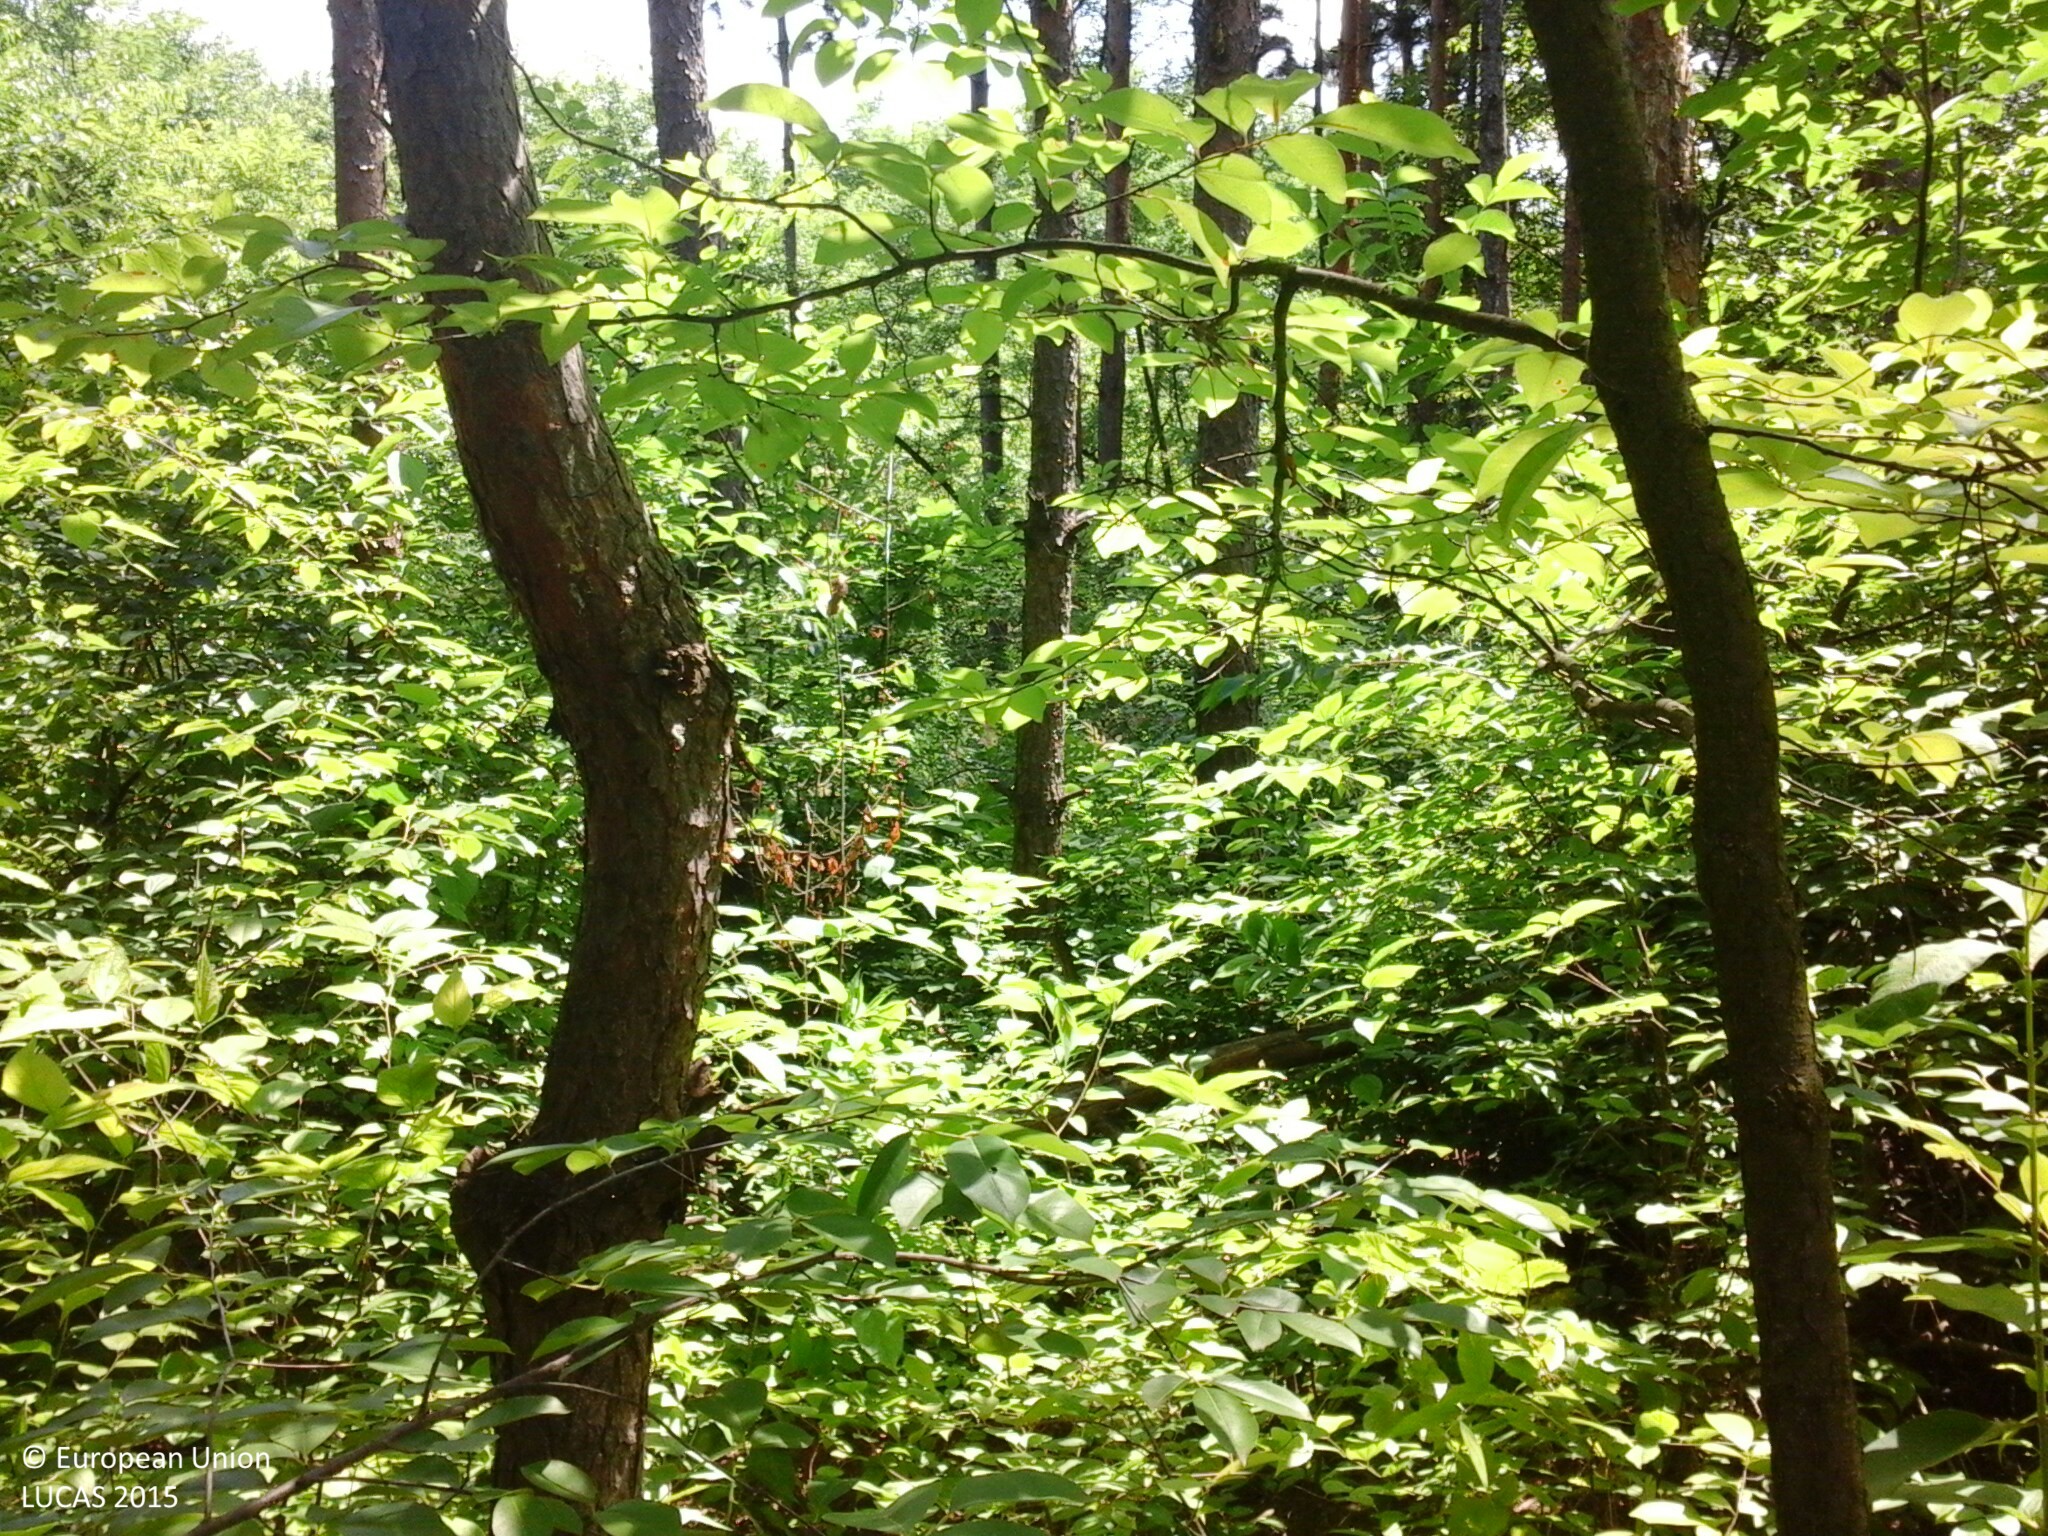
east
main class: Woodland
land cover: Pine dominated coniferous woodland
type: hemiboreal forest and nemoral coniferous forest and mixed broadleaved-coniferous forest
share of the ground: > 75 %
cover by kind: coniferous forest trees 95 %, broadleaved forest trees 5 %
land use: Forestry
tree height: > 5 m
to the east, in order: Pine dominated coniferous woodland; Broadleaved woodland
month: June
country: HU
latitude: 47.6372
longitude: 19.4314
